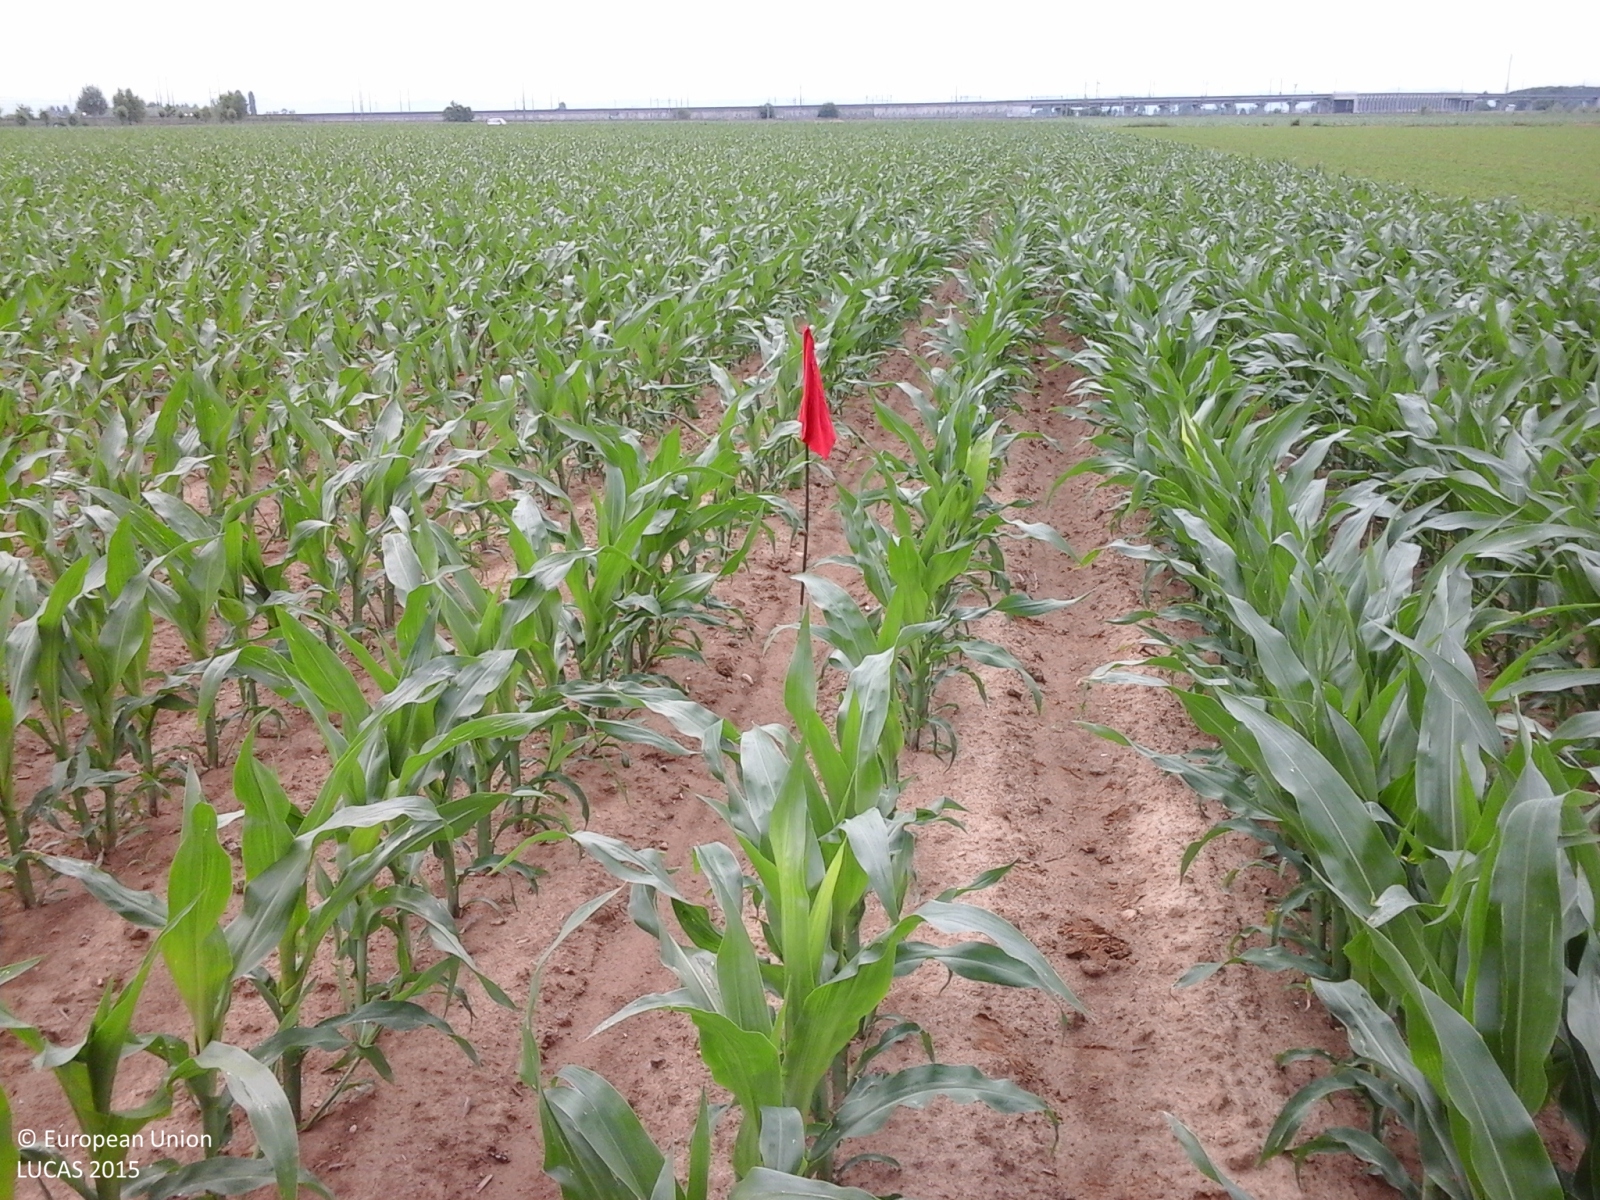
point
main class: Cropland
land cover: Maize
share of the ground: 50 - 75 %
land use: Agriculture (excluding fallow land and kitchen gardens)
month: May
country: IT
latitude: 45.3071
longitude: 8.1028
